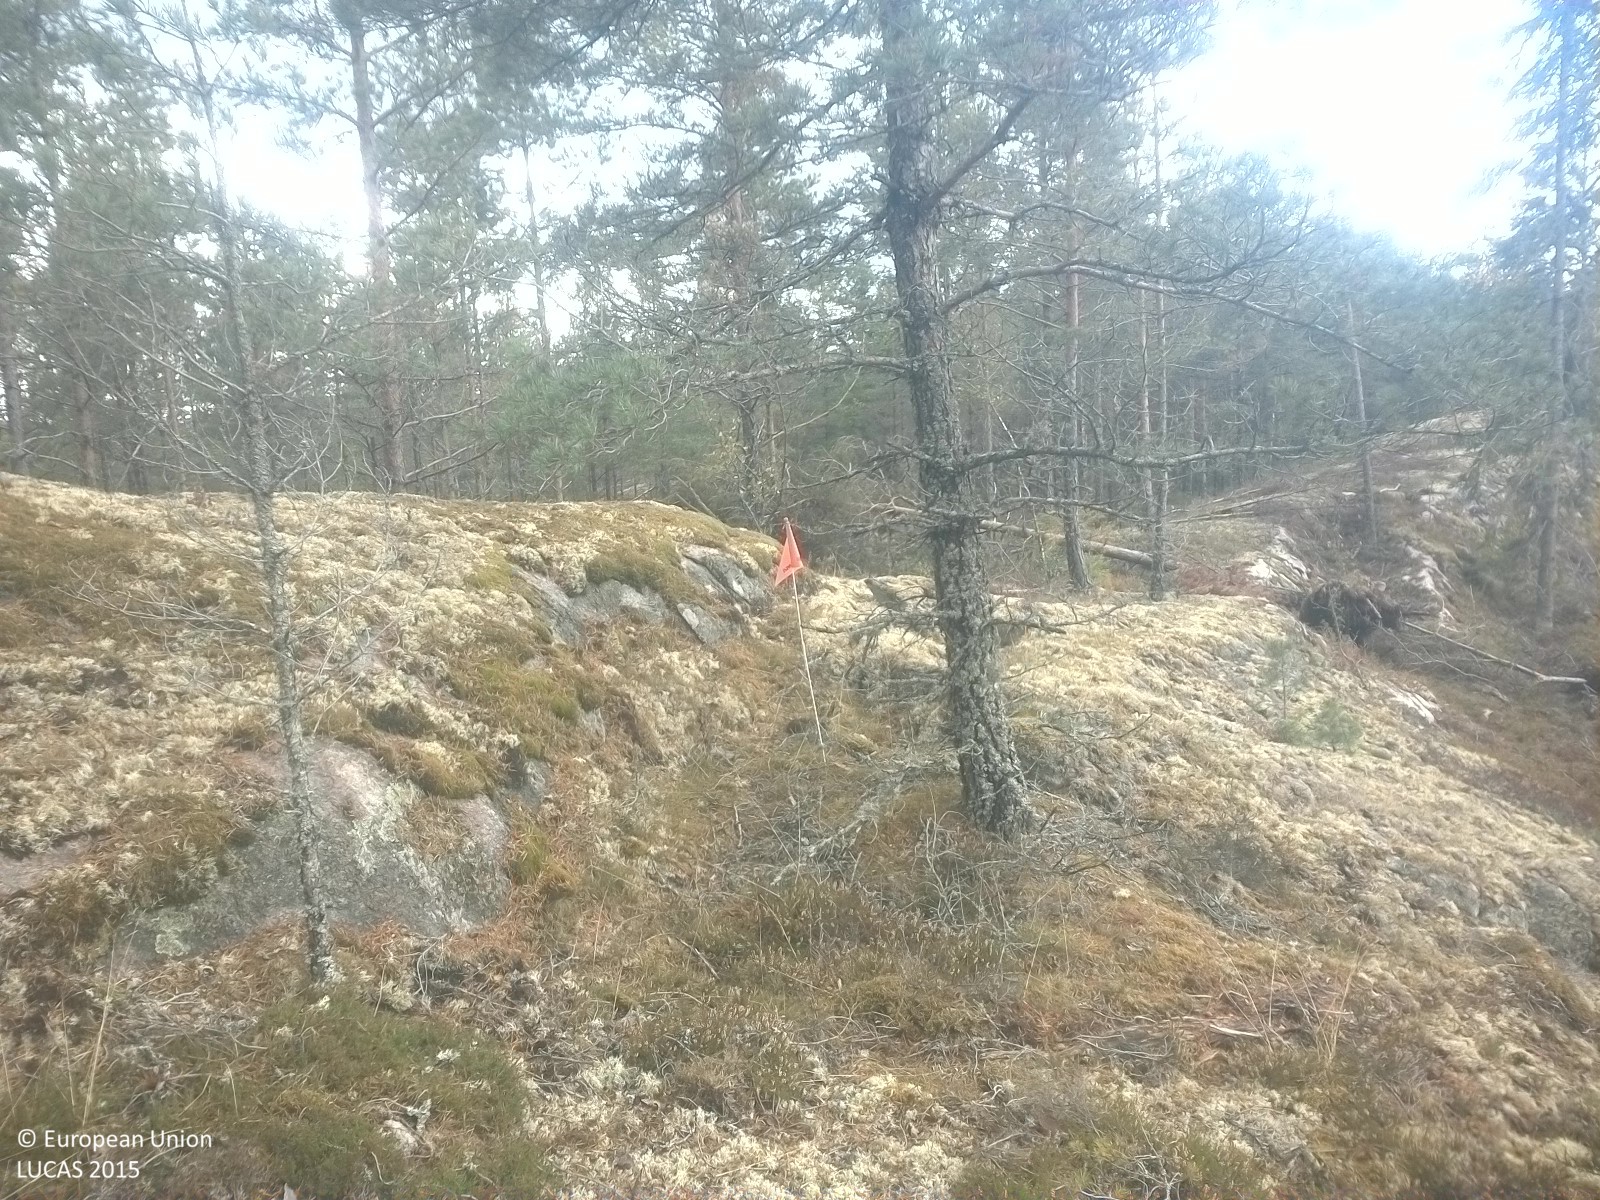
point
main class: Woodland
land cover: Pine dominated coniferous woodland
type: boreal forest
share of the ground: 10 - 25 %
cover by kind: lichens and mosses 60 %, coniferous forest trees 20 %, shrubs 15 %, herbaceous plants 5 %
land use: Forestry
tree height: < 5 m
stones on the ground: 10 - 25 %
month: September
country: SE
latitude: 58.7981
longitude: 16.2073
